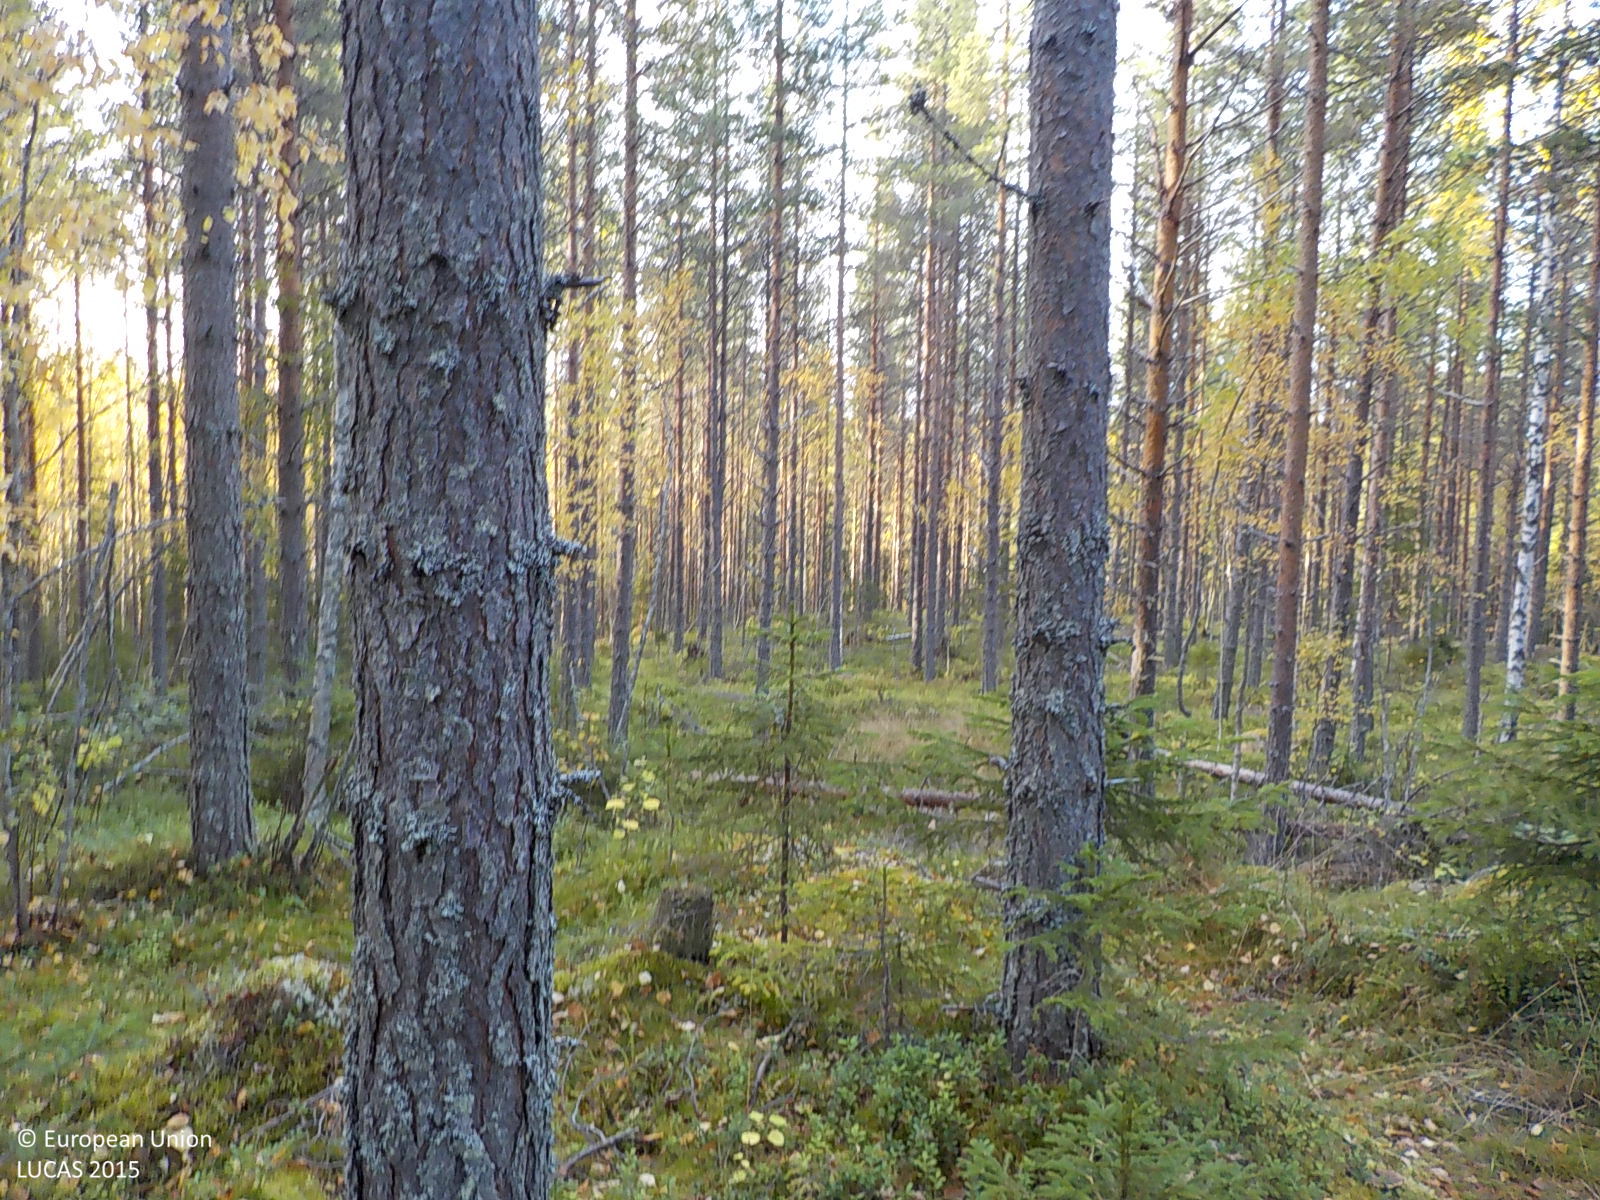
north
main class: Woodland
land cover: Pine dominated coniferous woodland
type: boreal forest
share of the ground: 50 - 75 %
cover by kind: coniferous forest trees 75 %, shrubs 25 %
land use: Forestry
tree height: > 5 m
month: September
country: SE
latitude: 63.4795
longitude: 17.0597
